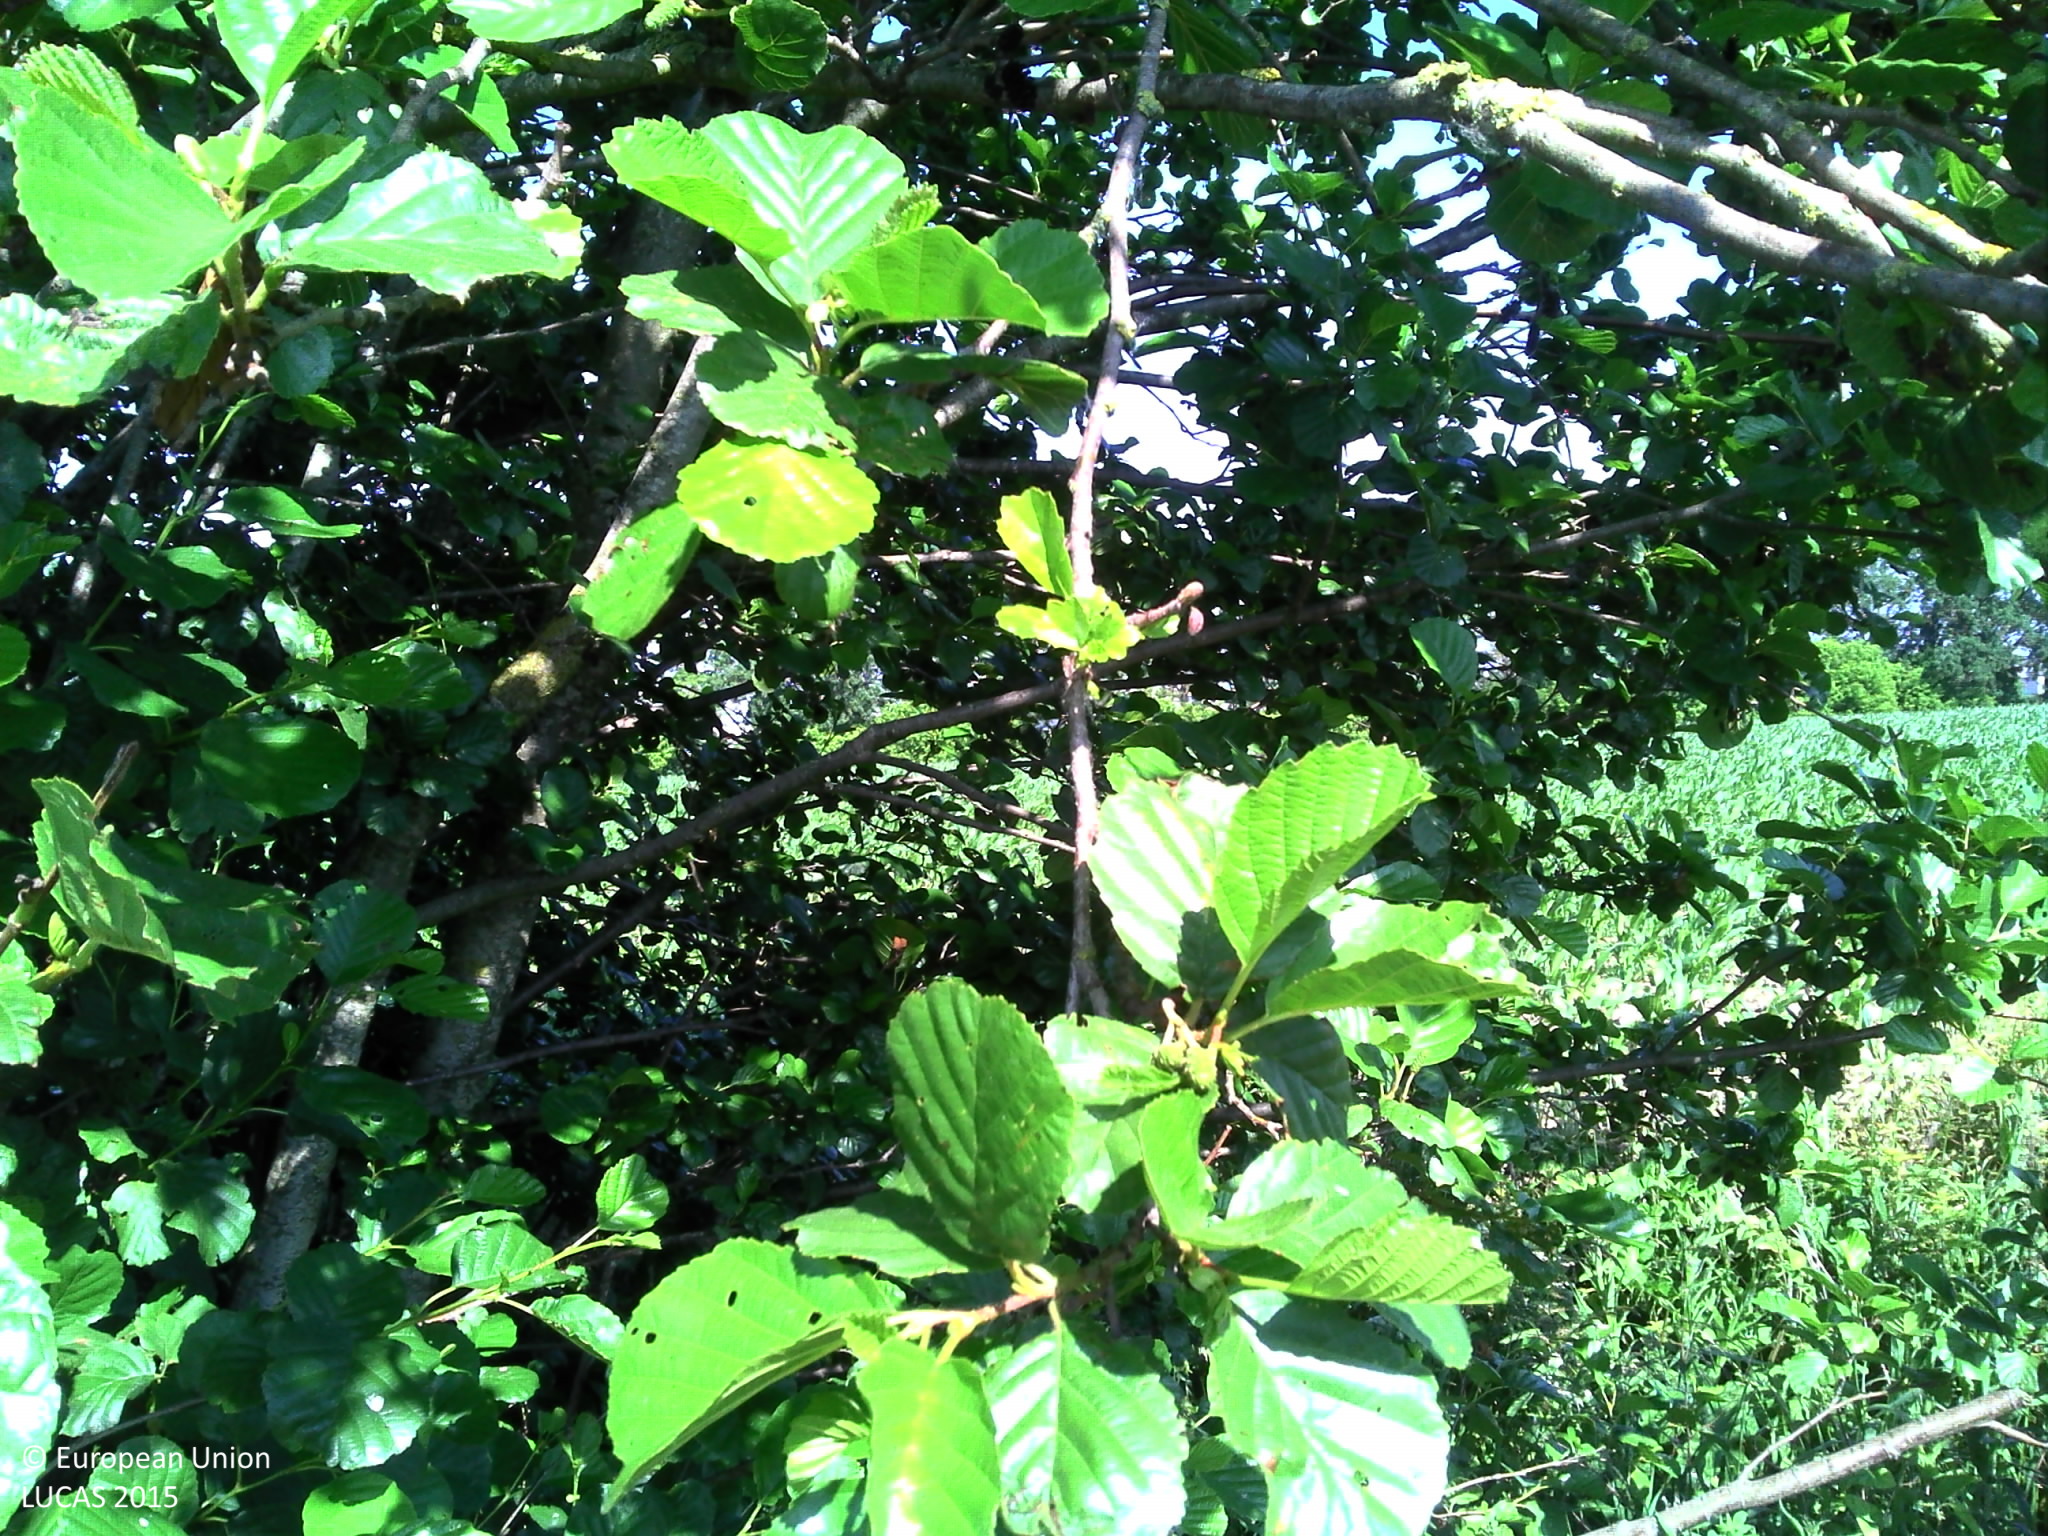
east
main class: Cropland
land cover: Maize
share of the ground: 50 - 75 %
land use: Agriculture (excluding fallow land and kitchen gardens)
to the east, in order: Abandoned hedges; Grass margins; Maize; Grass margins; Inland fresh running water; Grass margins; Fences; Grassland without tree/shrub cover; Fences; Abandoned hedges; Lines of trees; Inland fresh running water; Grass margins; Paved roads, cycling and walking lanes; Grass margins; Tracks; Managed hedges
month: June
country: BE
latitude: 50.8815
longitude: 2.8683
